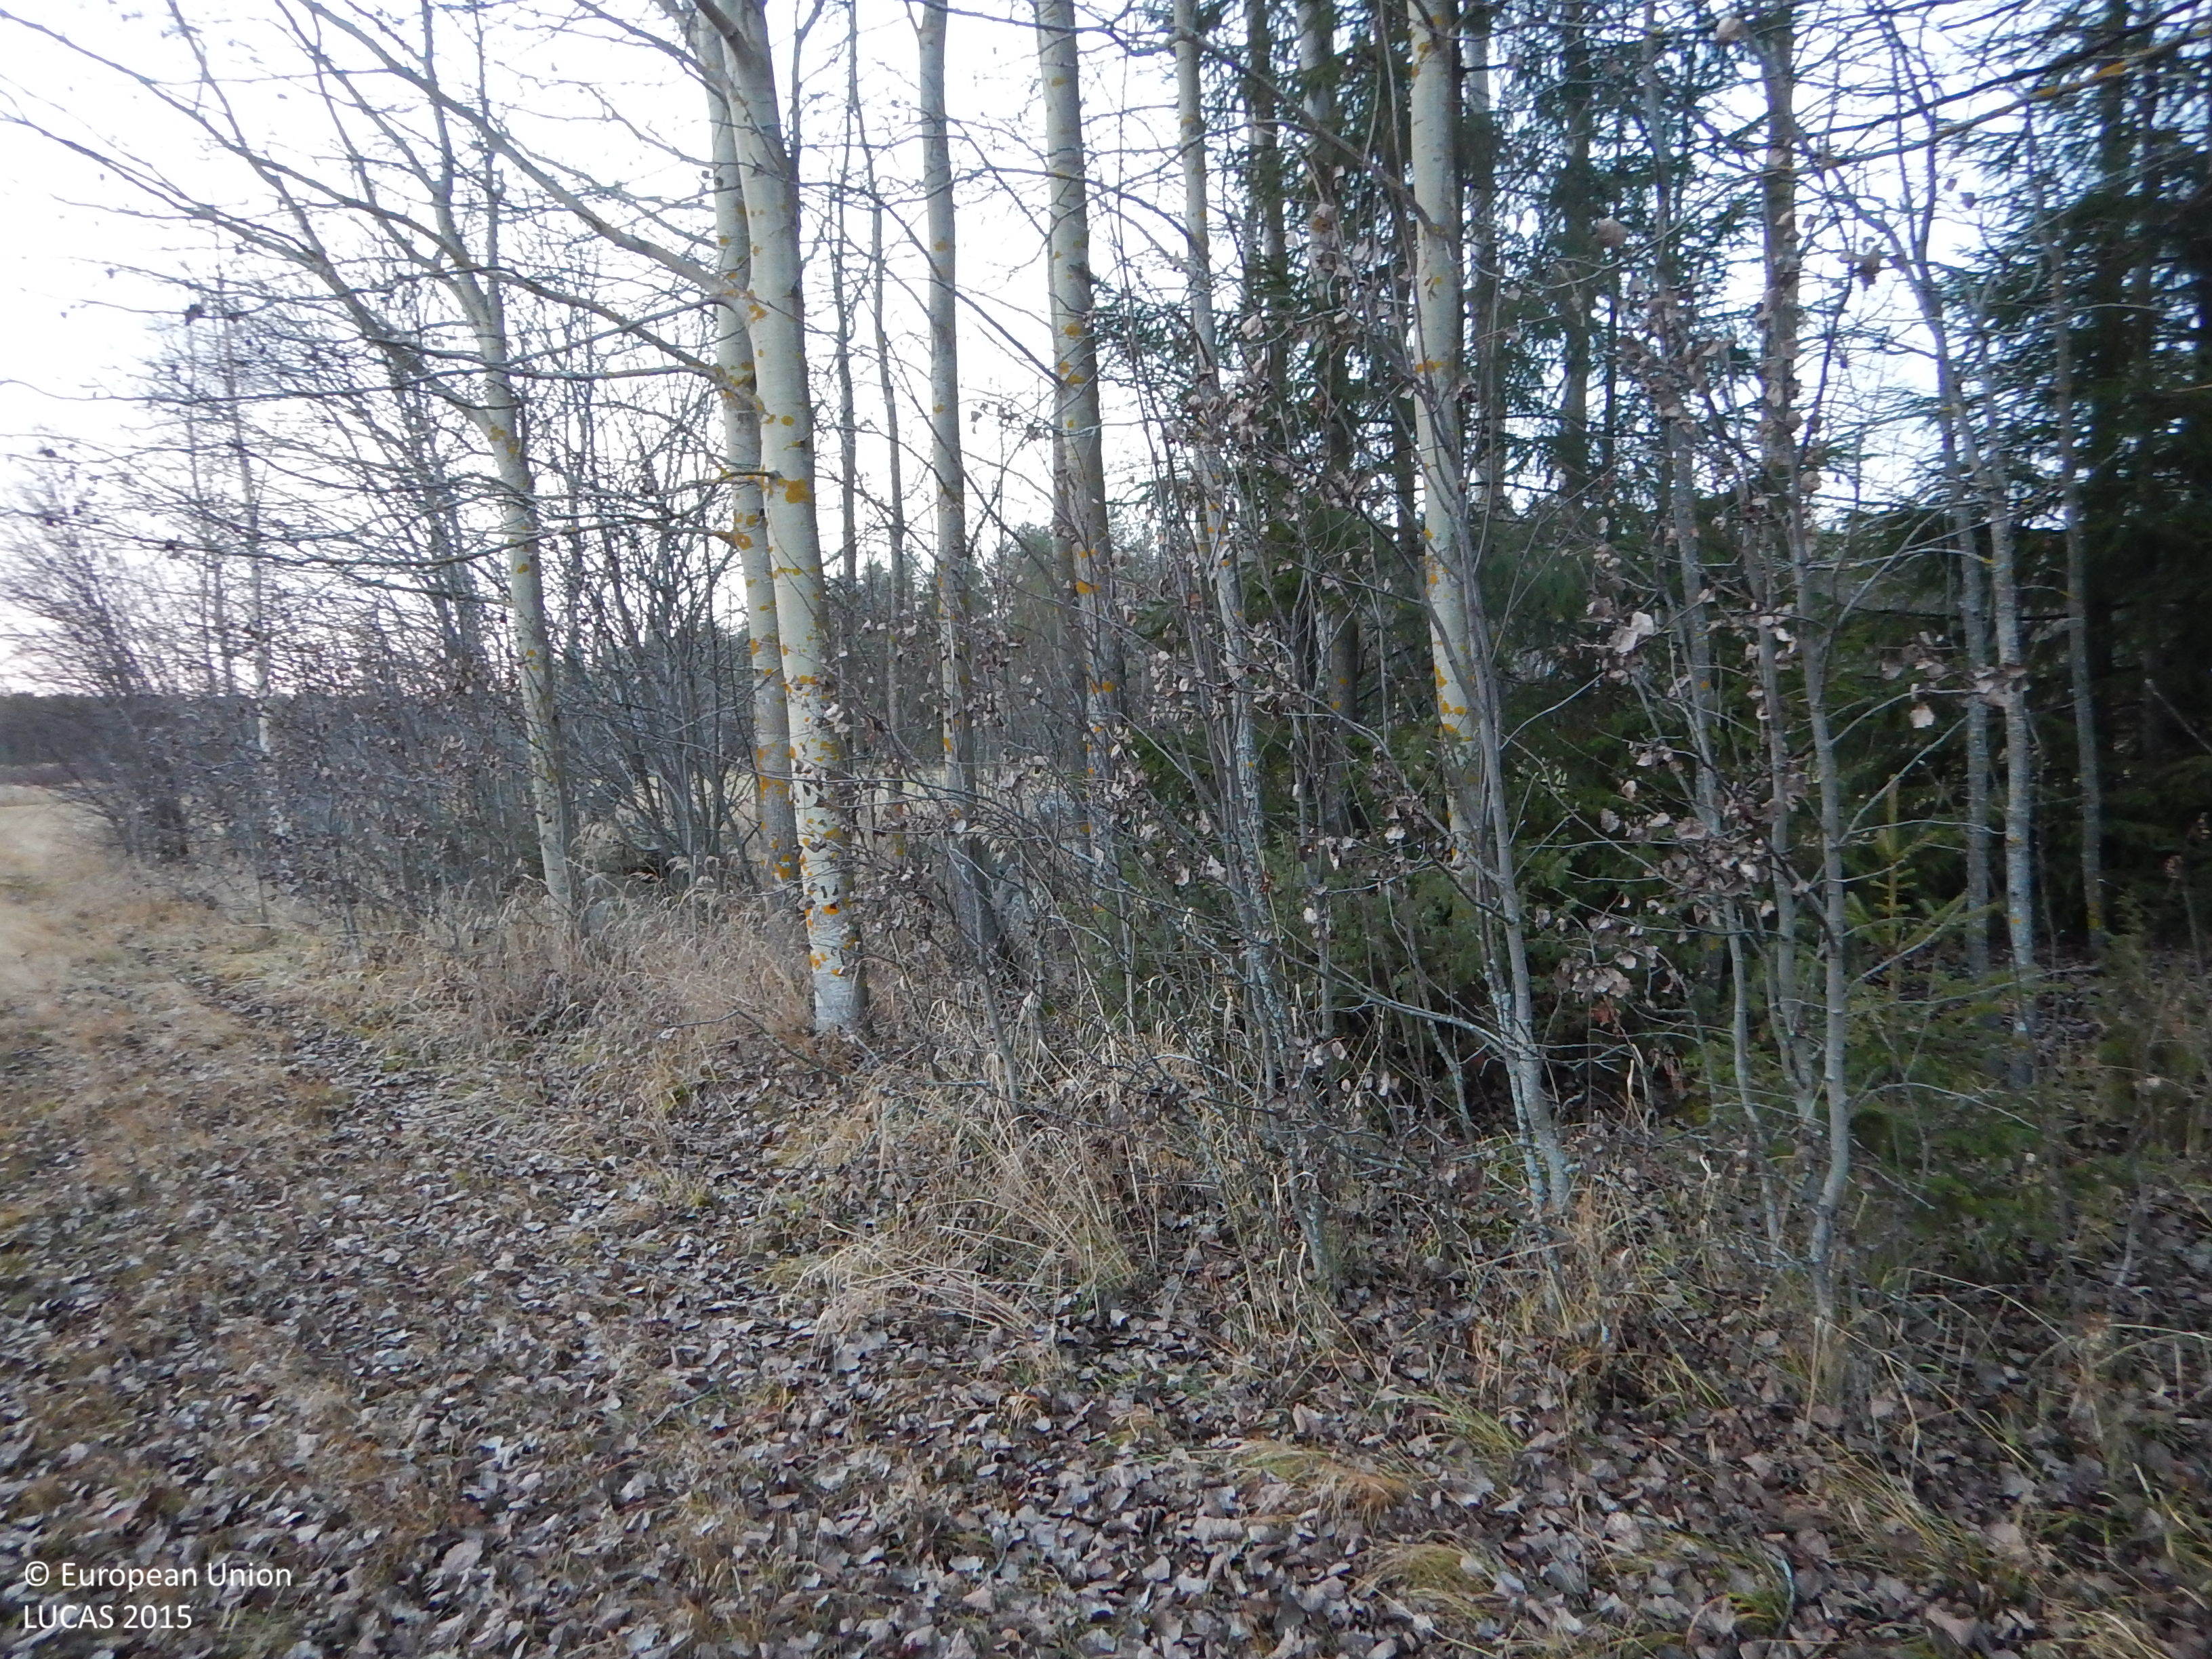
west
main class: Grassland
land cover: Grassland without tree/shrub cover
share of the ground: > 75 %
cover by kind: herbaceous plants 100 %
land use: Agriculture (excluding fallow land and kitchen gardens)
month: October
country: SE
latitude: 65.3678
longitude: 21.2627
